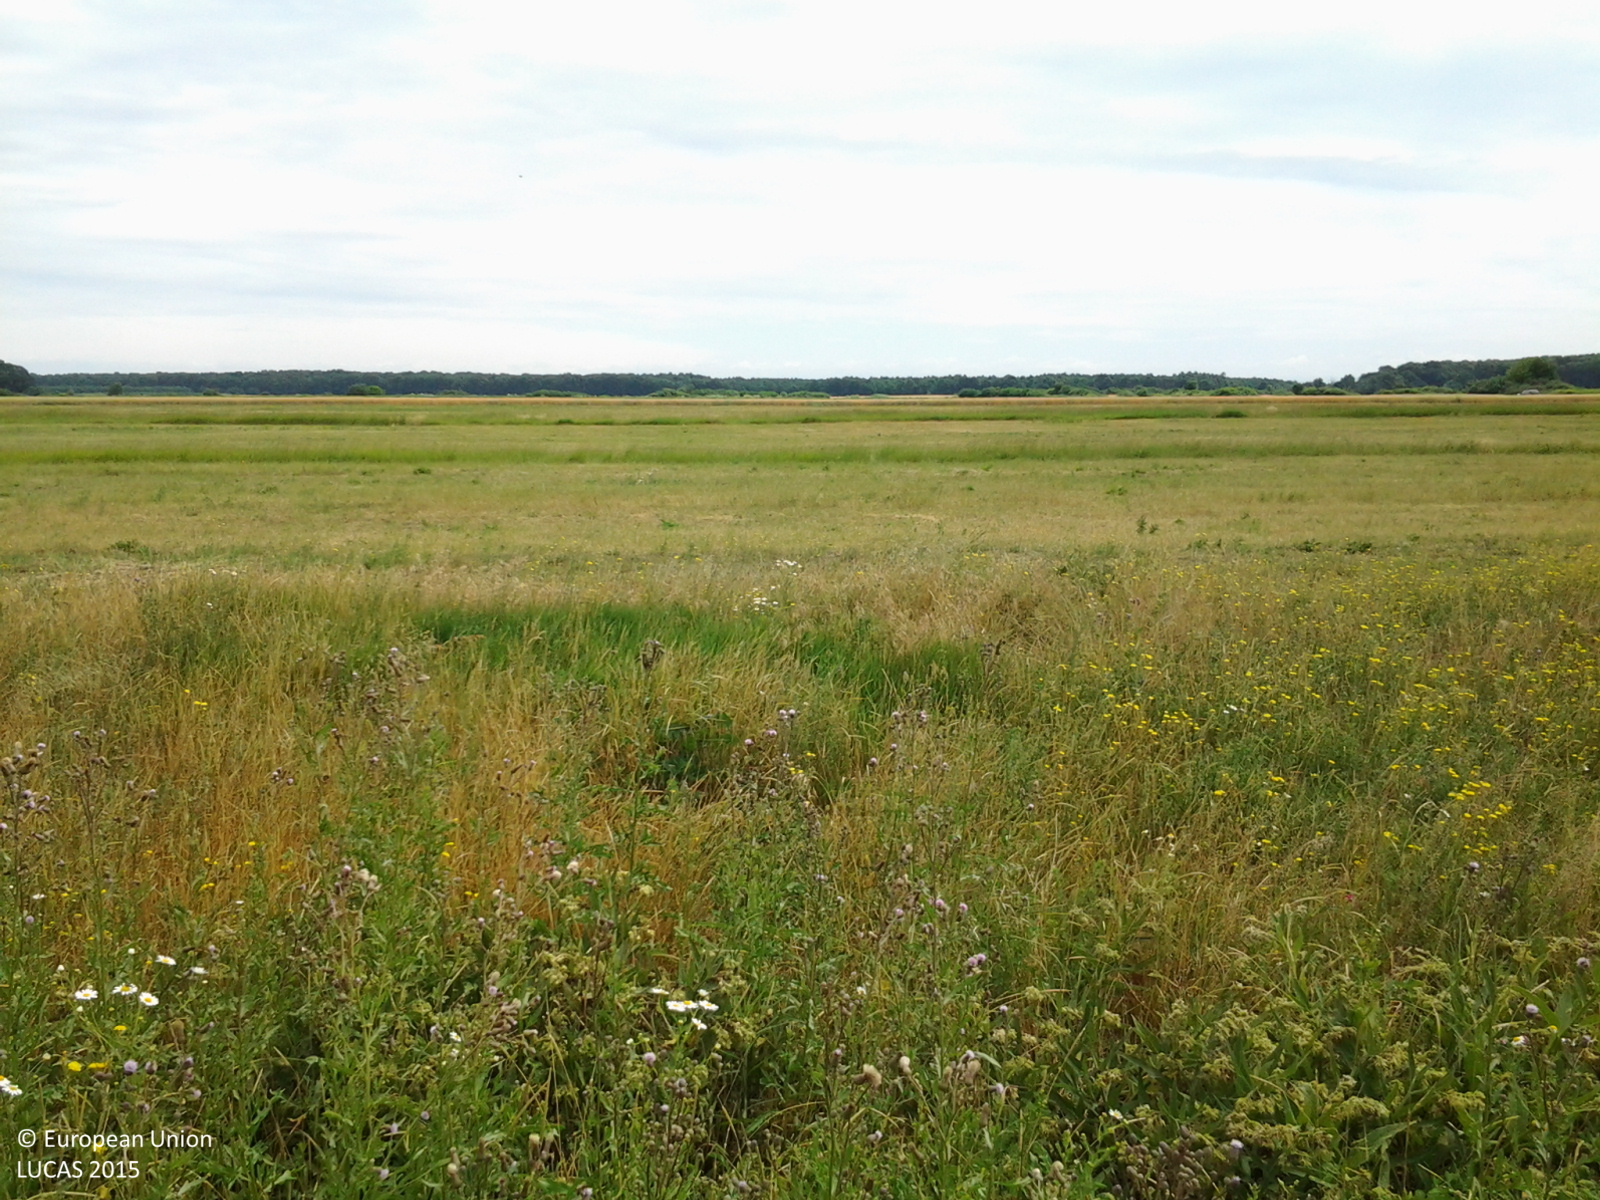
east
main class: Grassland
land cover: Grassland without tree/shrub cover
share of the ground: > 75 %
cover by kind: herbaceous plants 100 %
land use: Agriculture (excluding fallow land and kitchen gardens)
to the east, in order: Grassland without tree/shrub cover; Lucerne; Common wheat
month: June
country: HU
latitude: 46.6317
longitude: 21.3878
